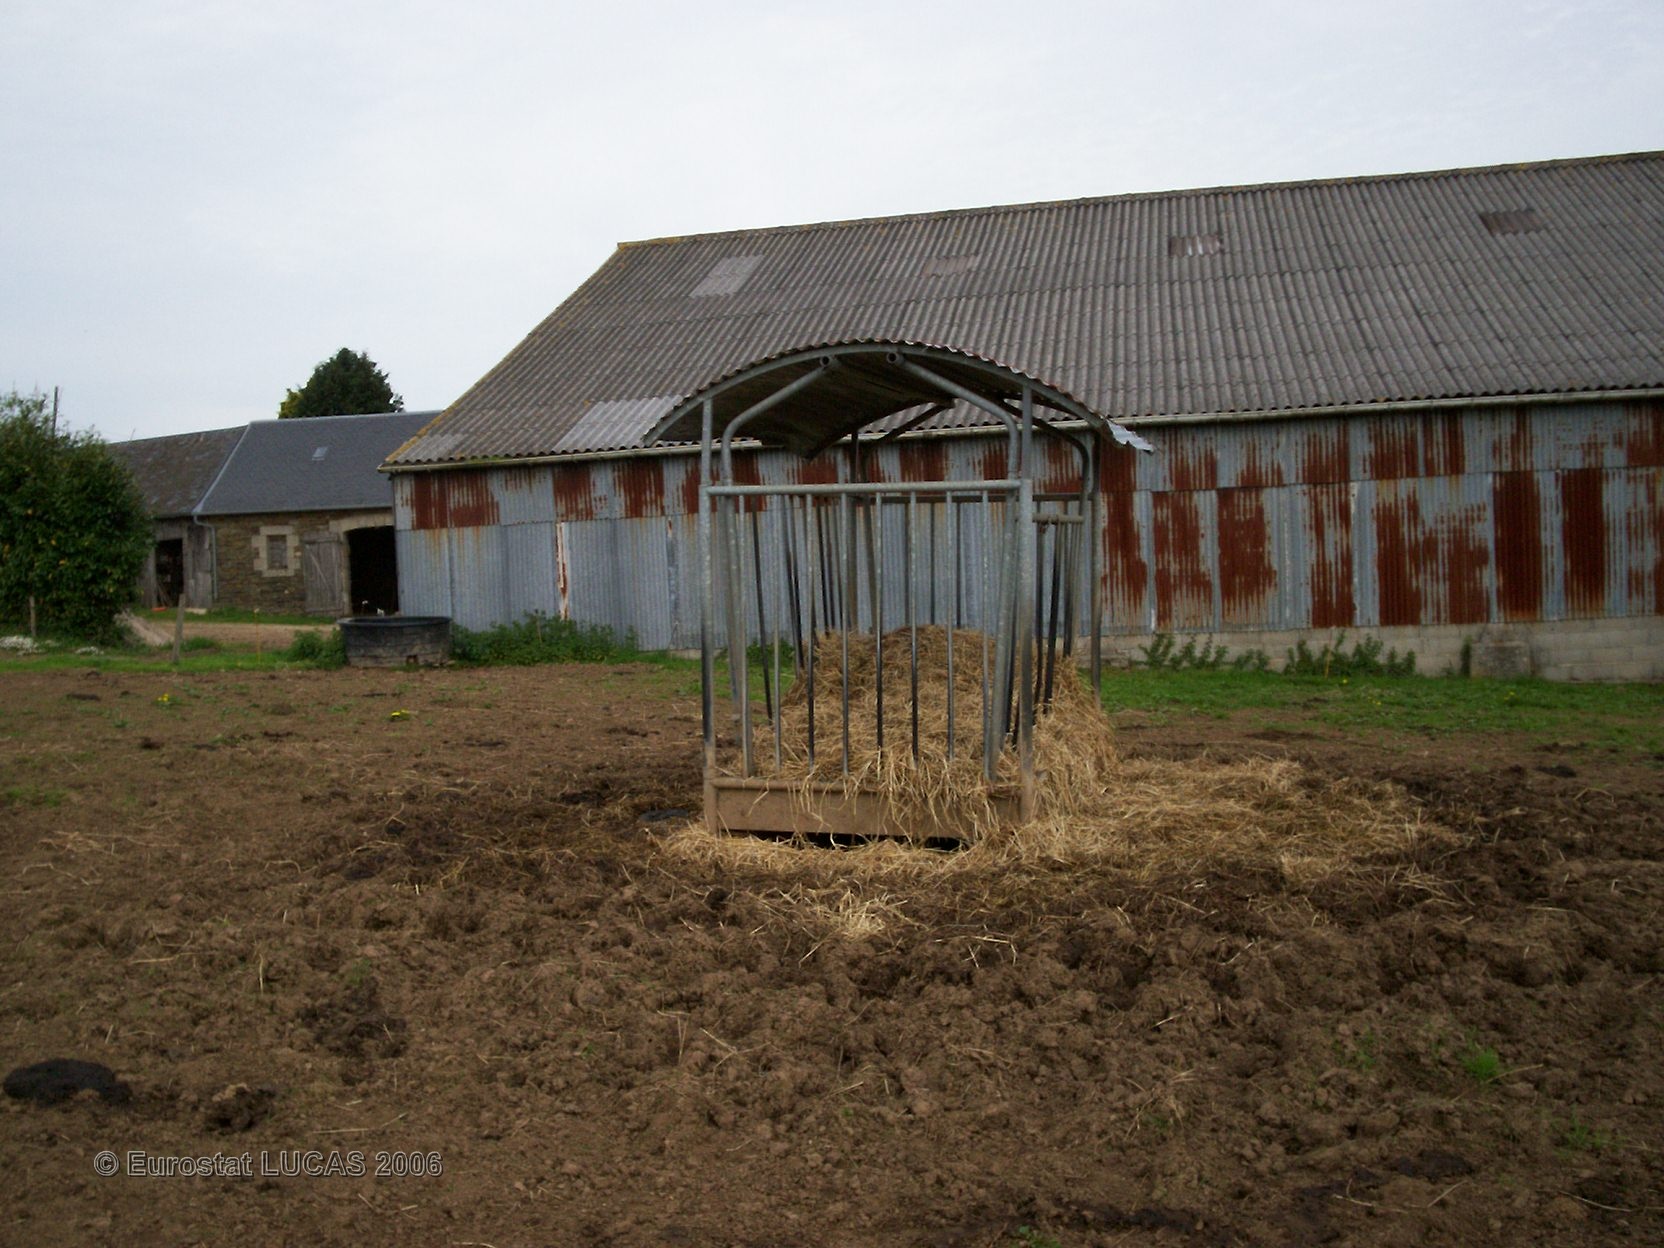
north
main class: Grassland
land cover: Grassland without tree/shrub cover
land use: Agriculture (excluding fallow land and kitchen gardens)
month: May
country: FR
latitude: 48.2063
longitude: -3.9598
